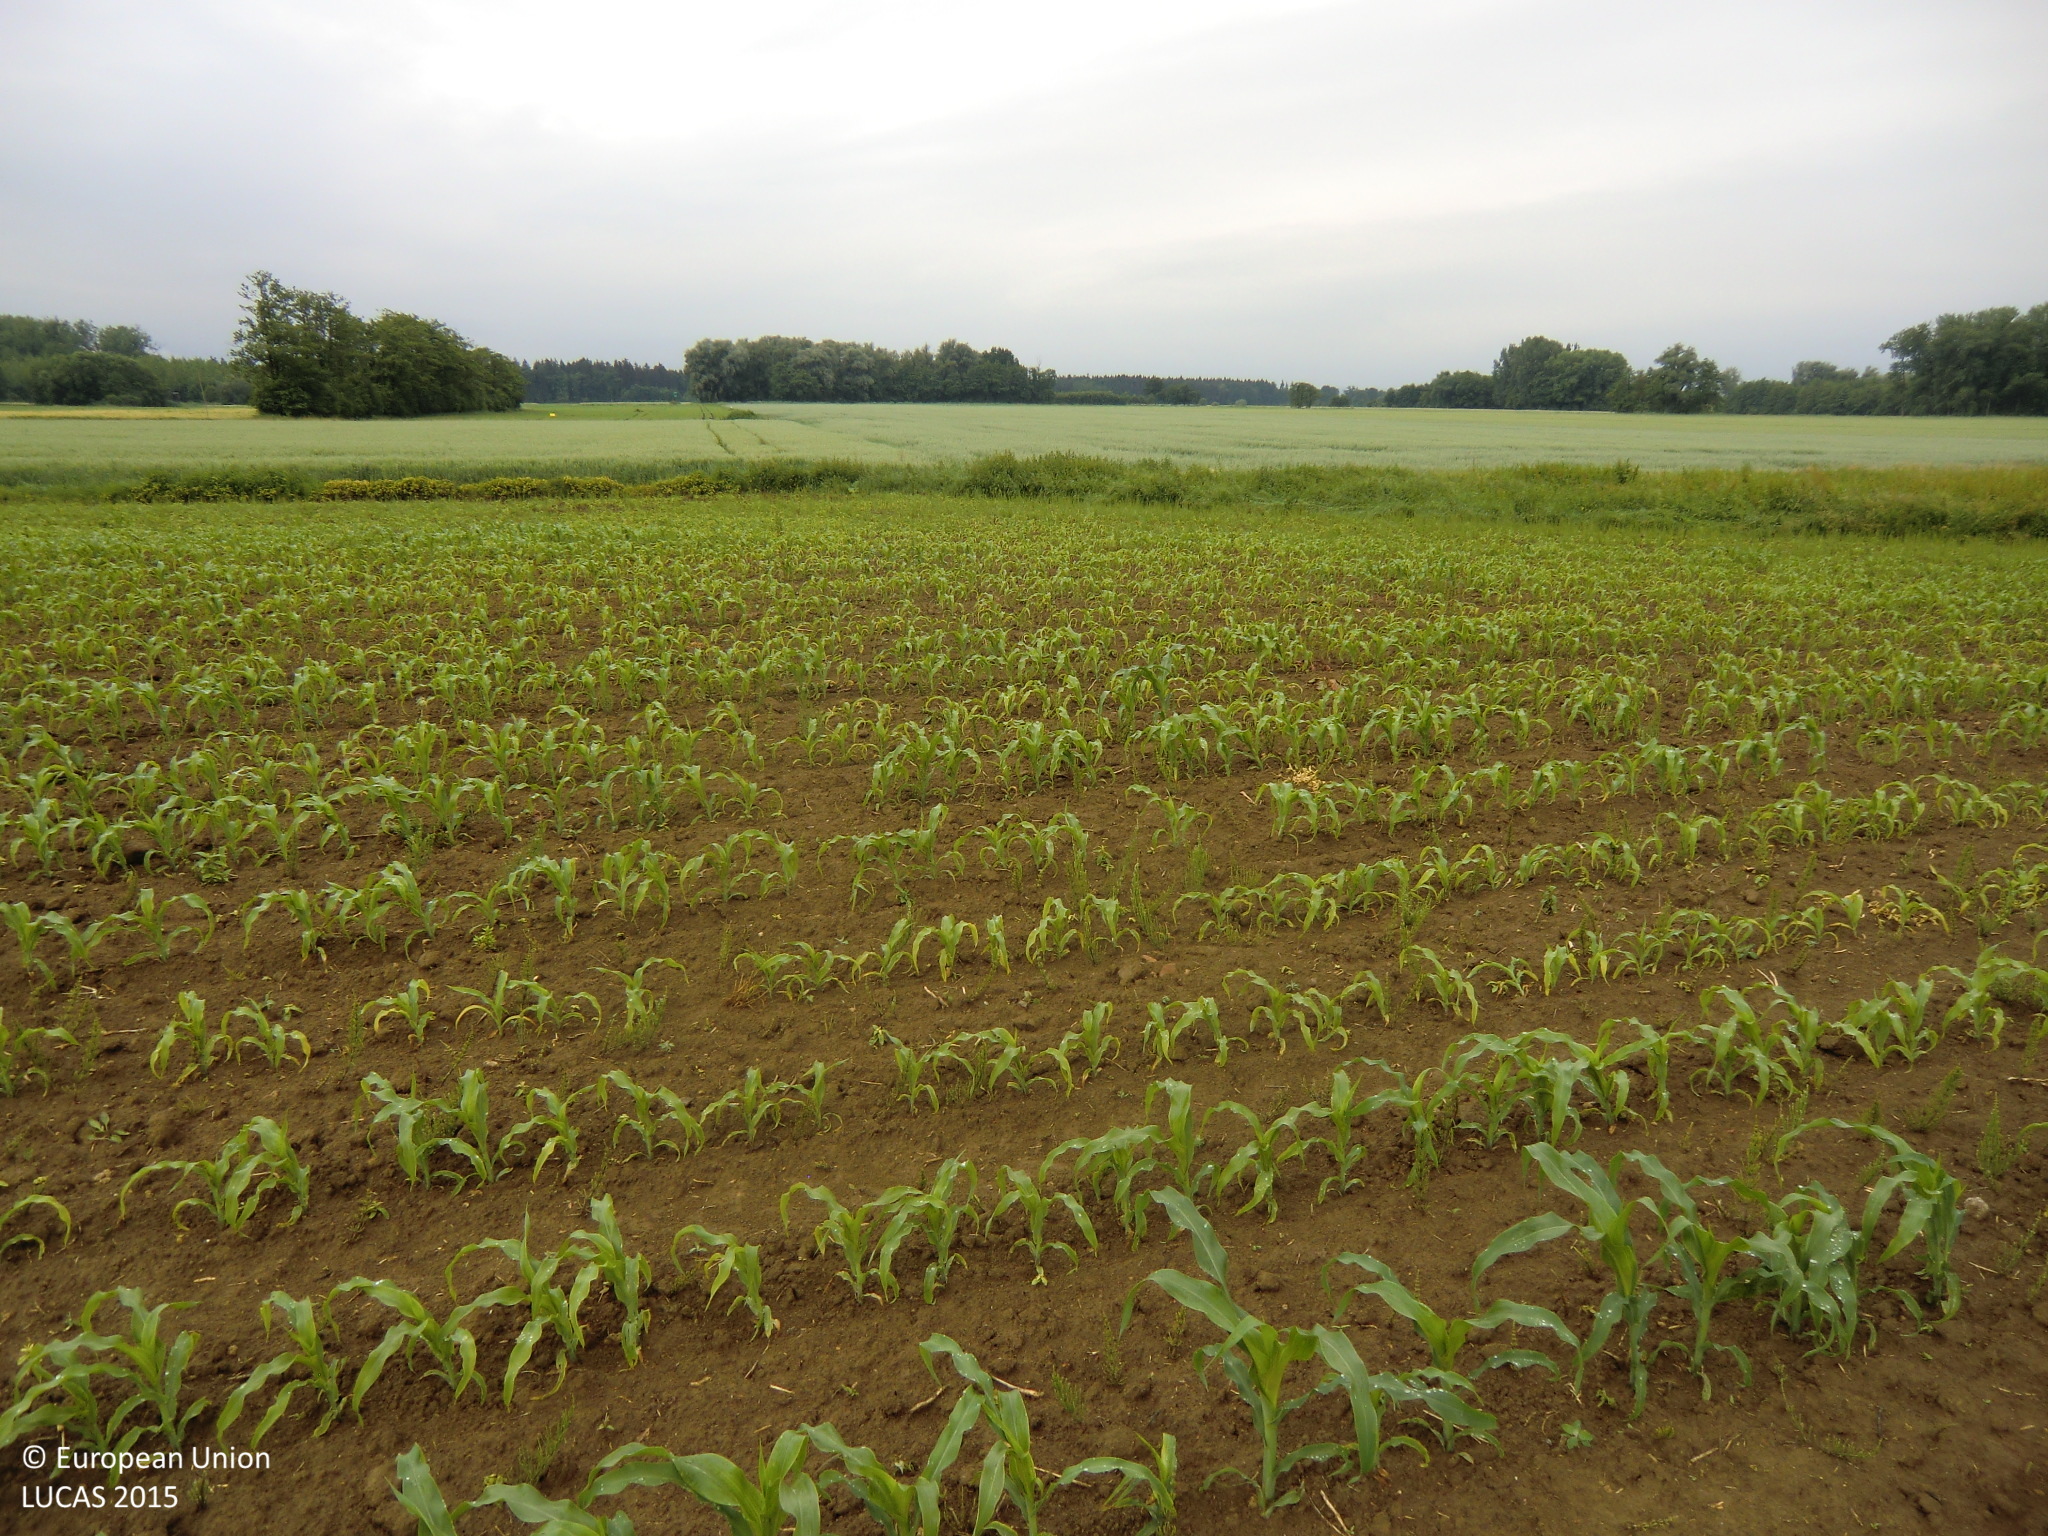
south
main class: Cropland
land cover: Maize
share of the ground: 25 - 50 %
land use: Agriculture (excluding fallow land and kitchen gardens)
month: June
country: AT
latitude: 48.2327
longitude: 14.6723
